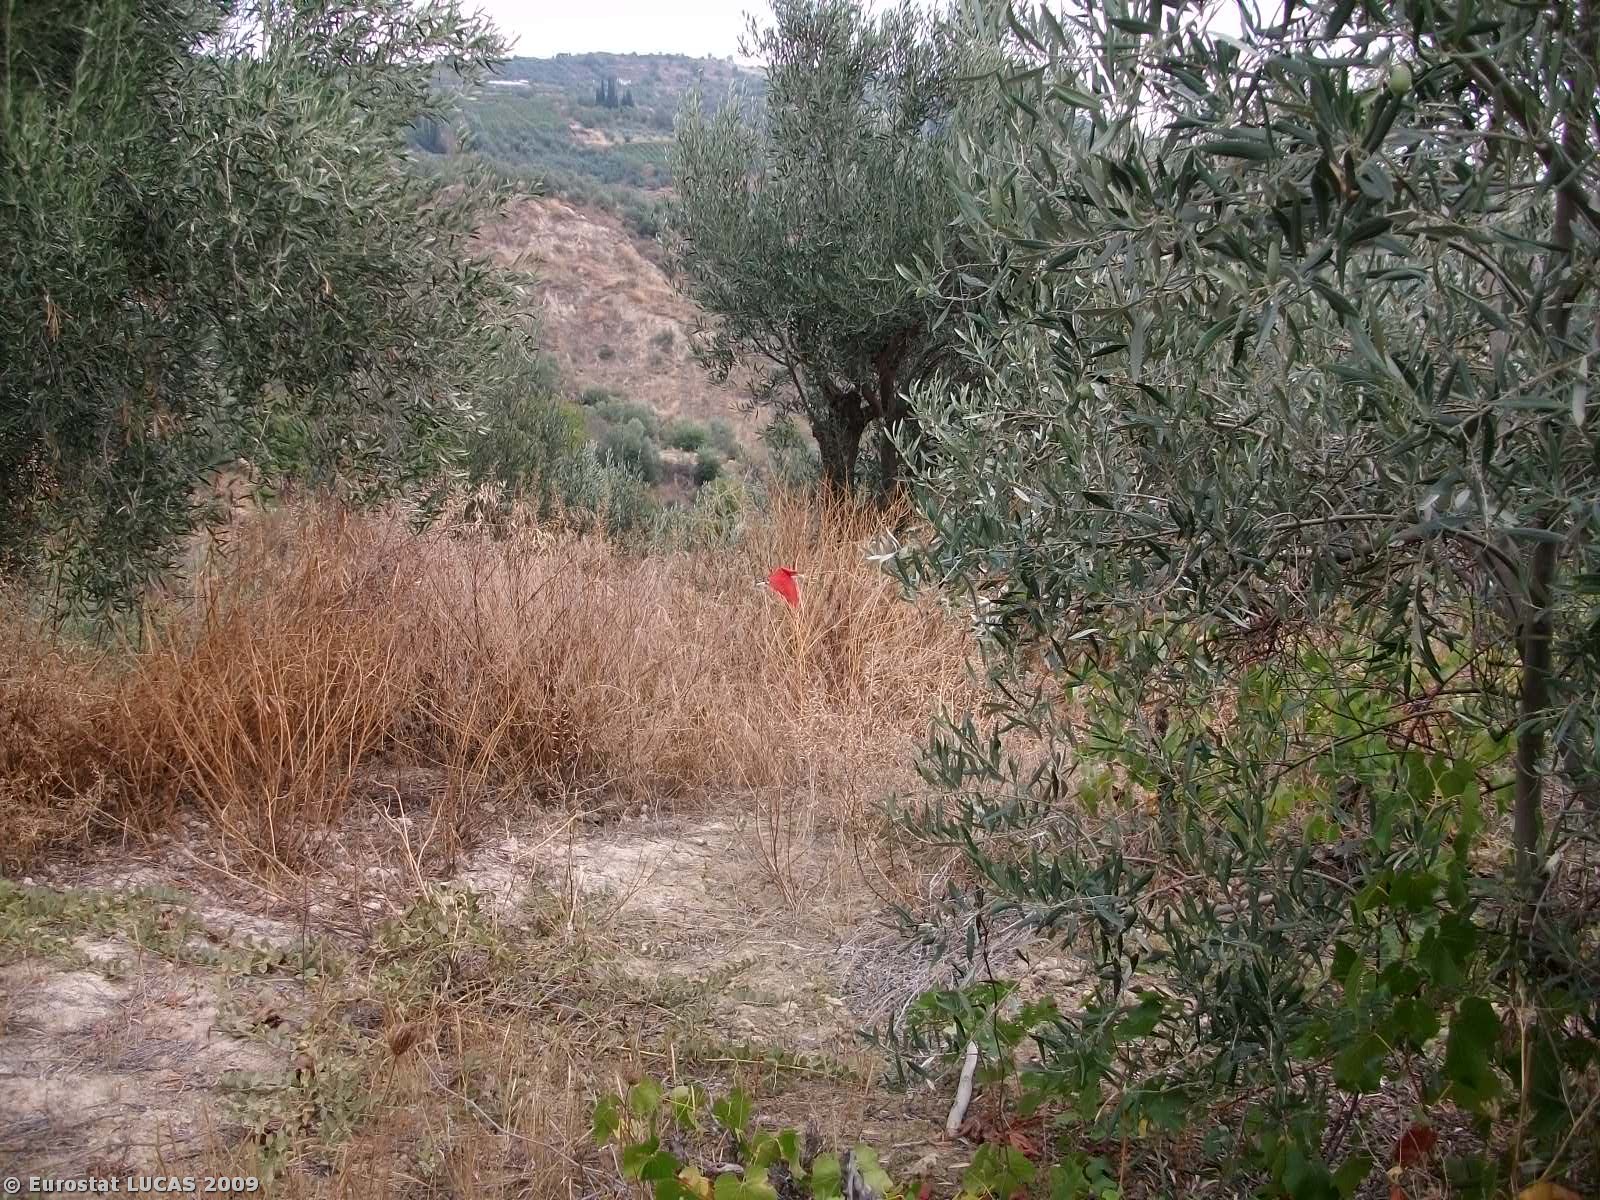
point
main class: Cropland
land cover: Olive groves
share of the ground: 50 - 75 %
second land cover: Vineyards
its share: < 10 %
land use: Agriculture (excluding fallow land and kitchen gardens)
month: September
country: GR
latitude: 38.0172
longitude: 22.5109
